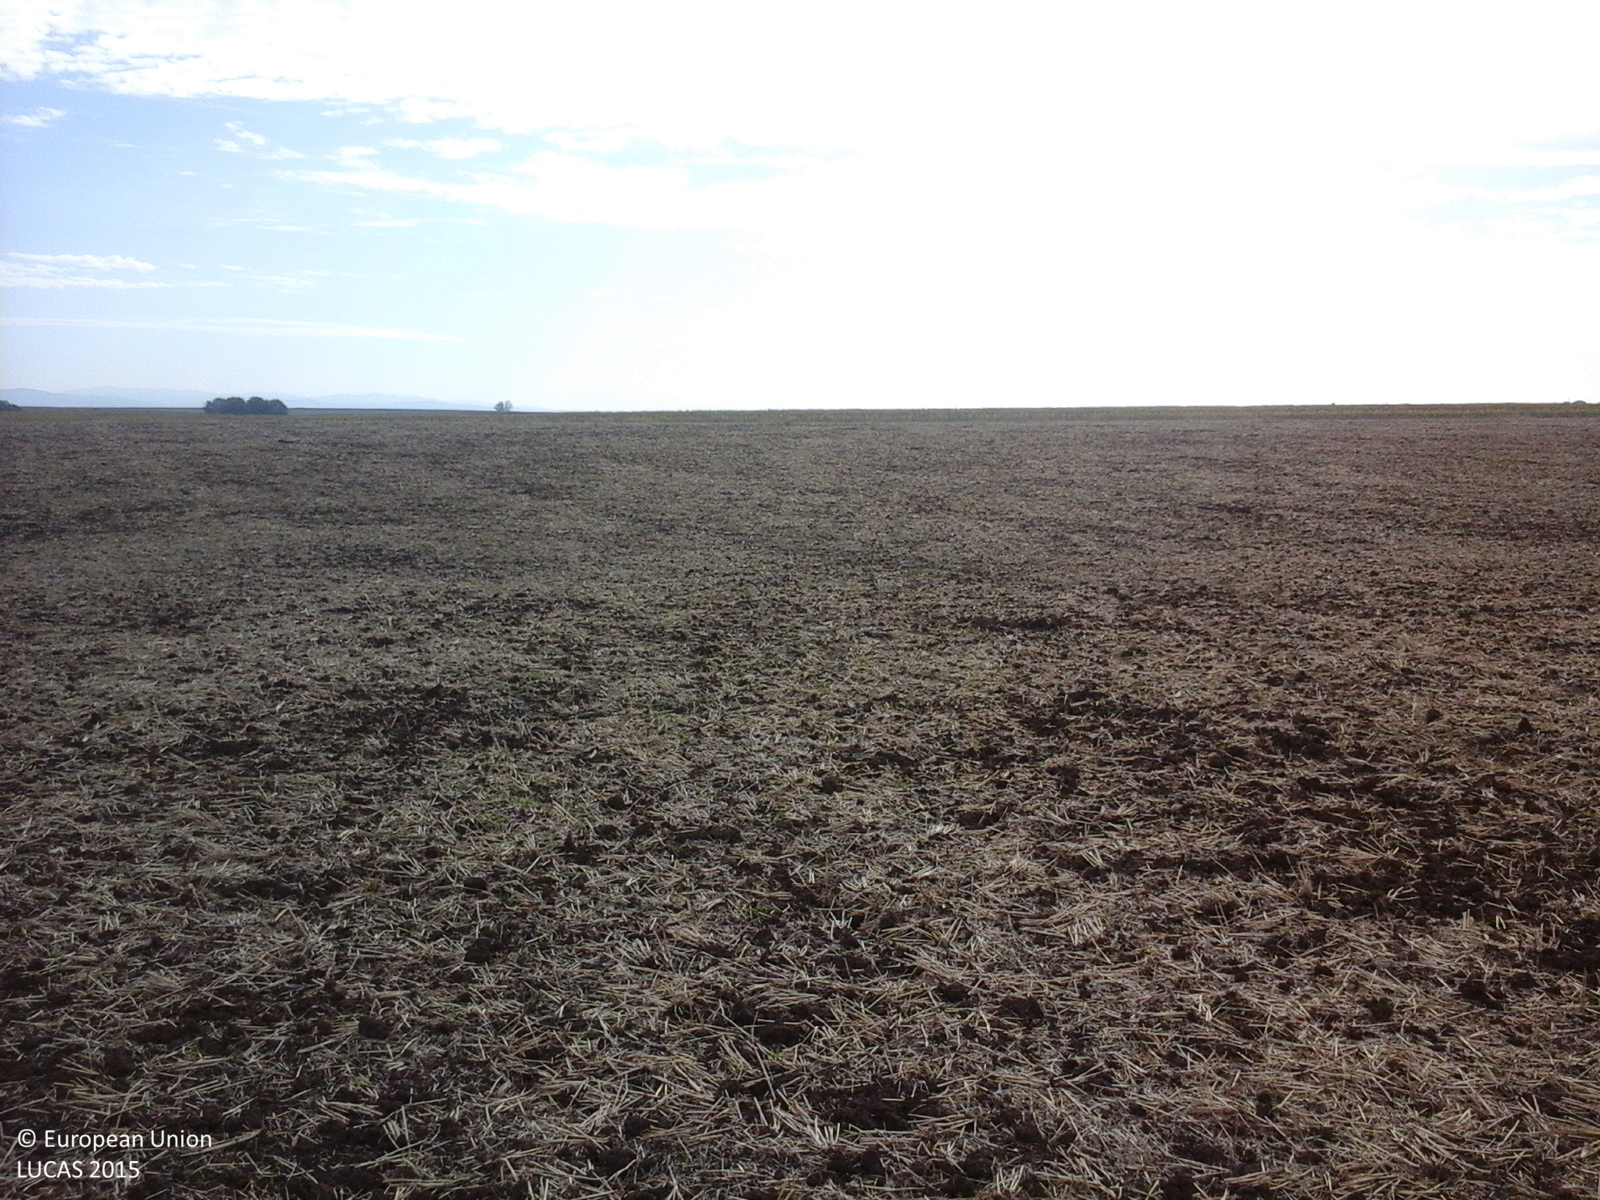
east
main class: Cropland
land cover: Common wheat
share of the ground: 25 - 50 %
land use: Agriculture (excluding fallow land and kitchen gardens)
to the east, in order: Common wheat; Sunflower; Maize
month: August
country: RO
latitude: 46.0904
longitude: 21.3506
